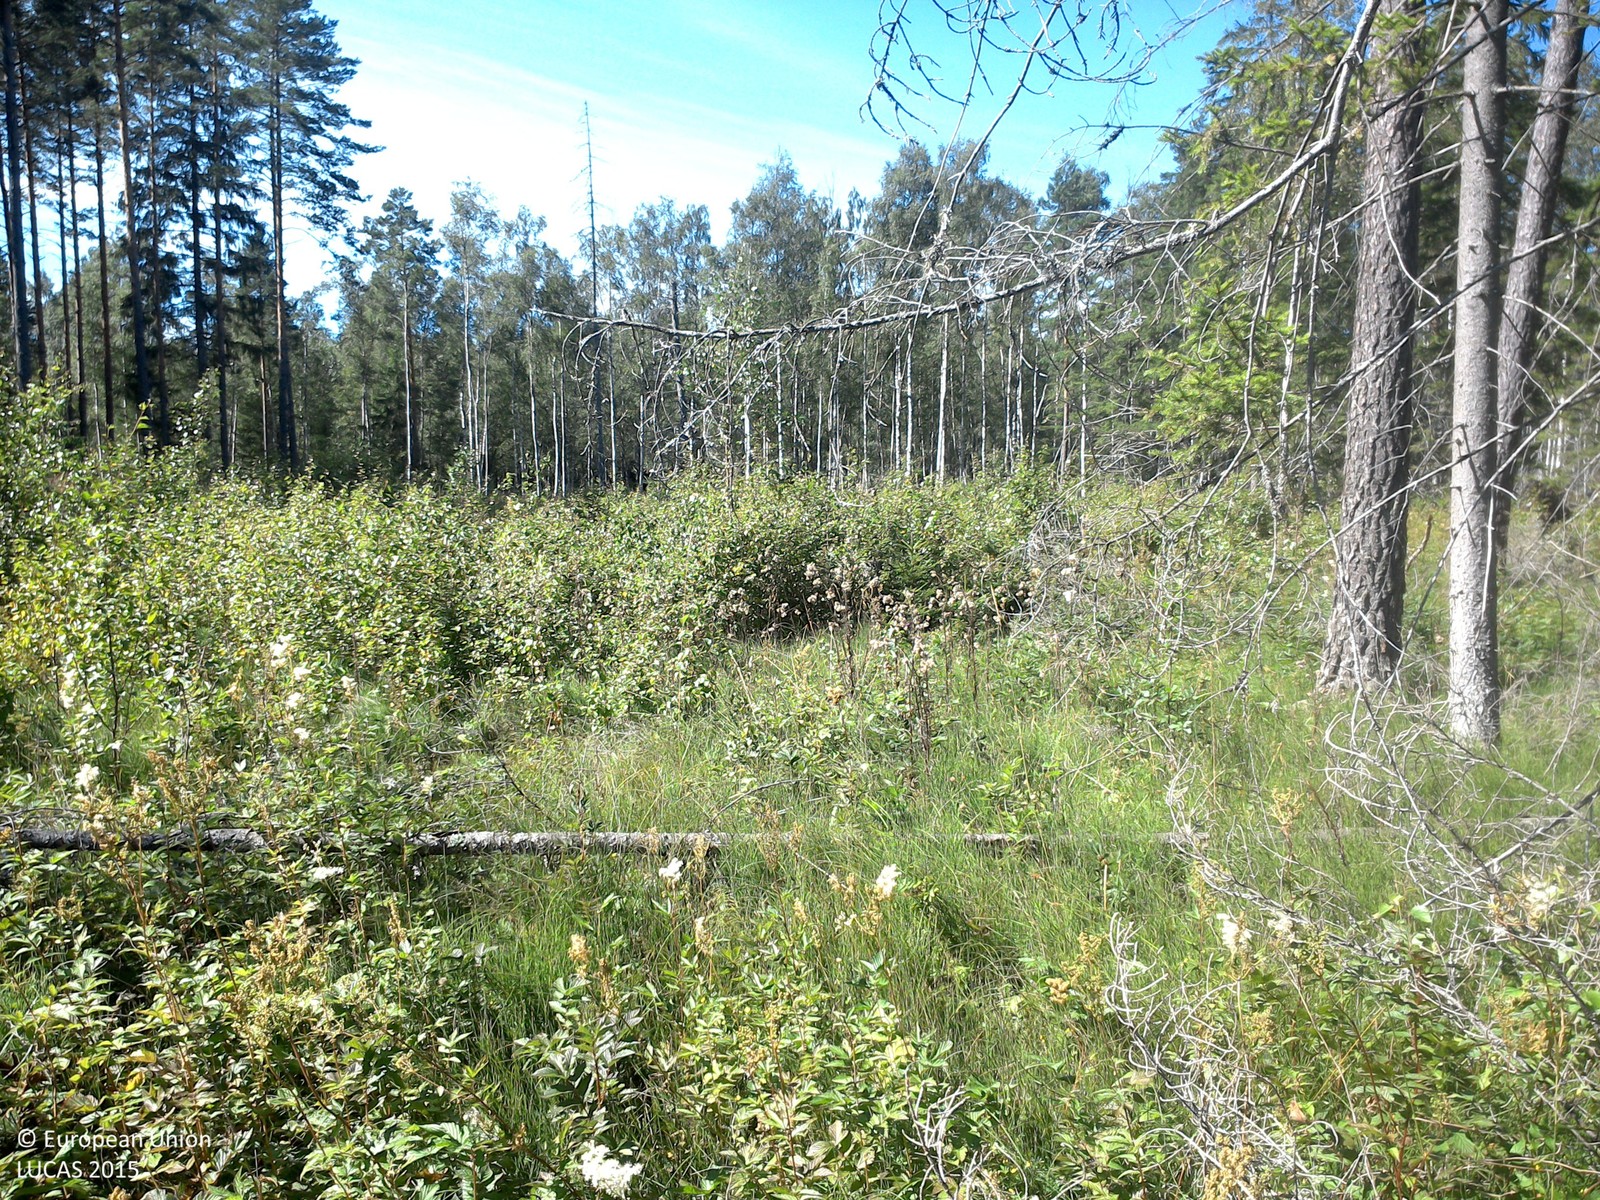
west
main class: Grassland
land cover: Spontaneously vegetated surfaces
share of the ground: > 75 %
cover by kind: herbaceous plants 95 %, shrubs 5 %
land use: Forestry
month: August
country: SE
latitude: 58.2866
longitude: 15.0598
